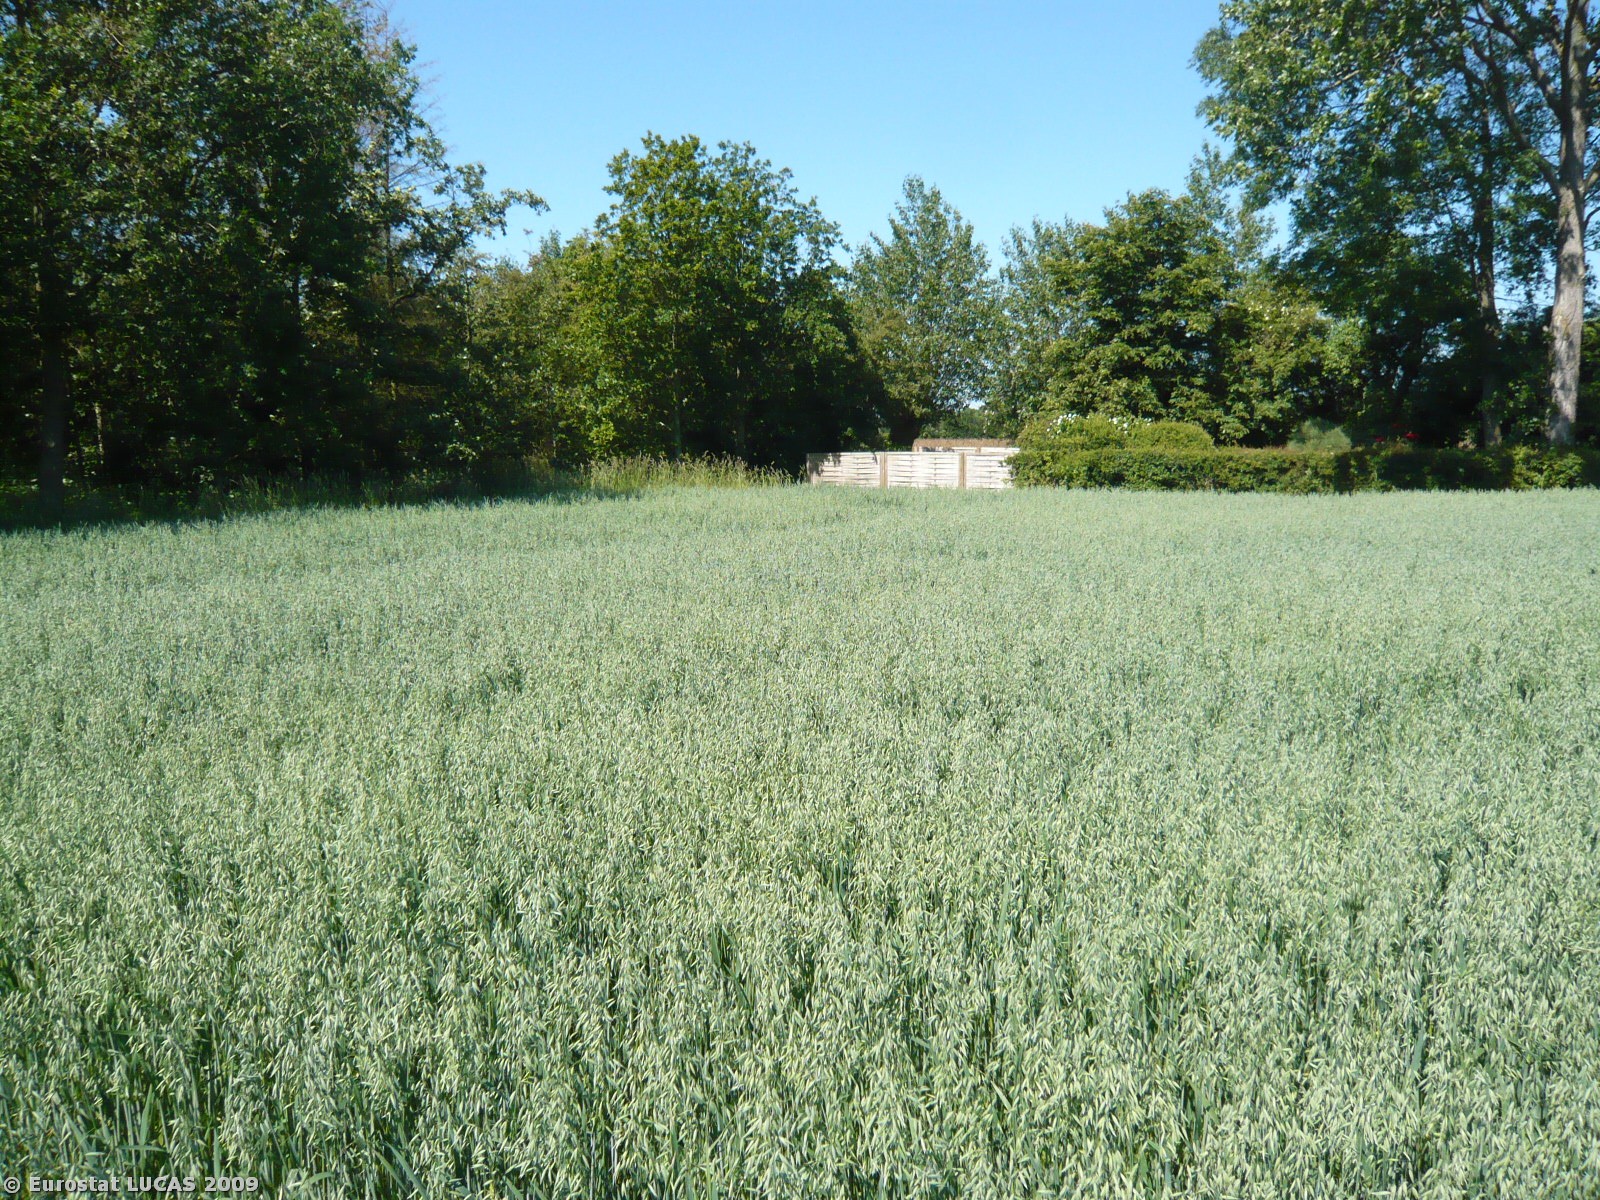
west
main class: Cropland
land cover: Oats
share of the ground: > 75 %
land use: Agriculture (excluding fallow land and kitchen gardens)
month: June
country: DK
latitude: 54.9639
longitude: 10.6399
